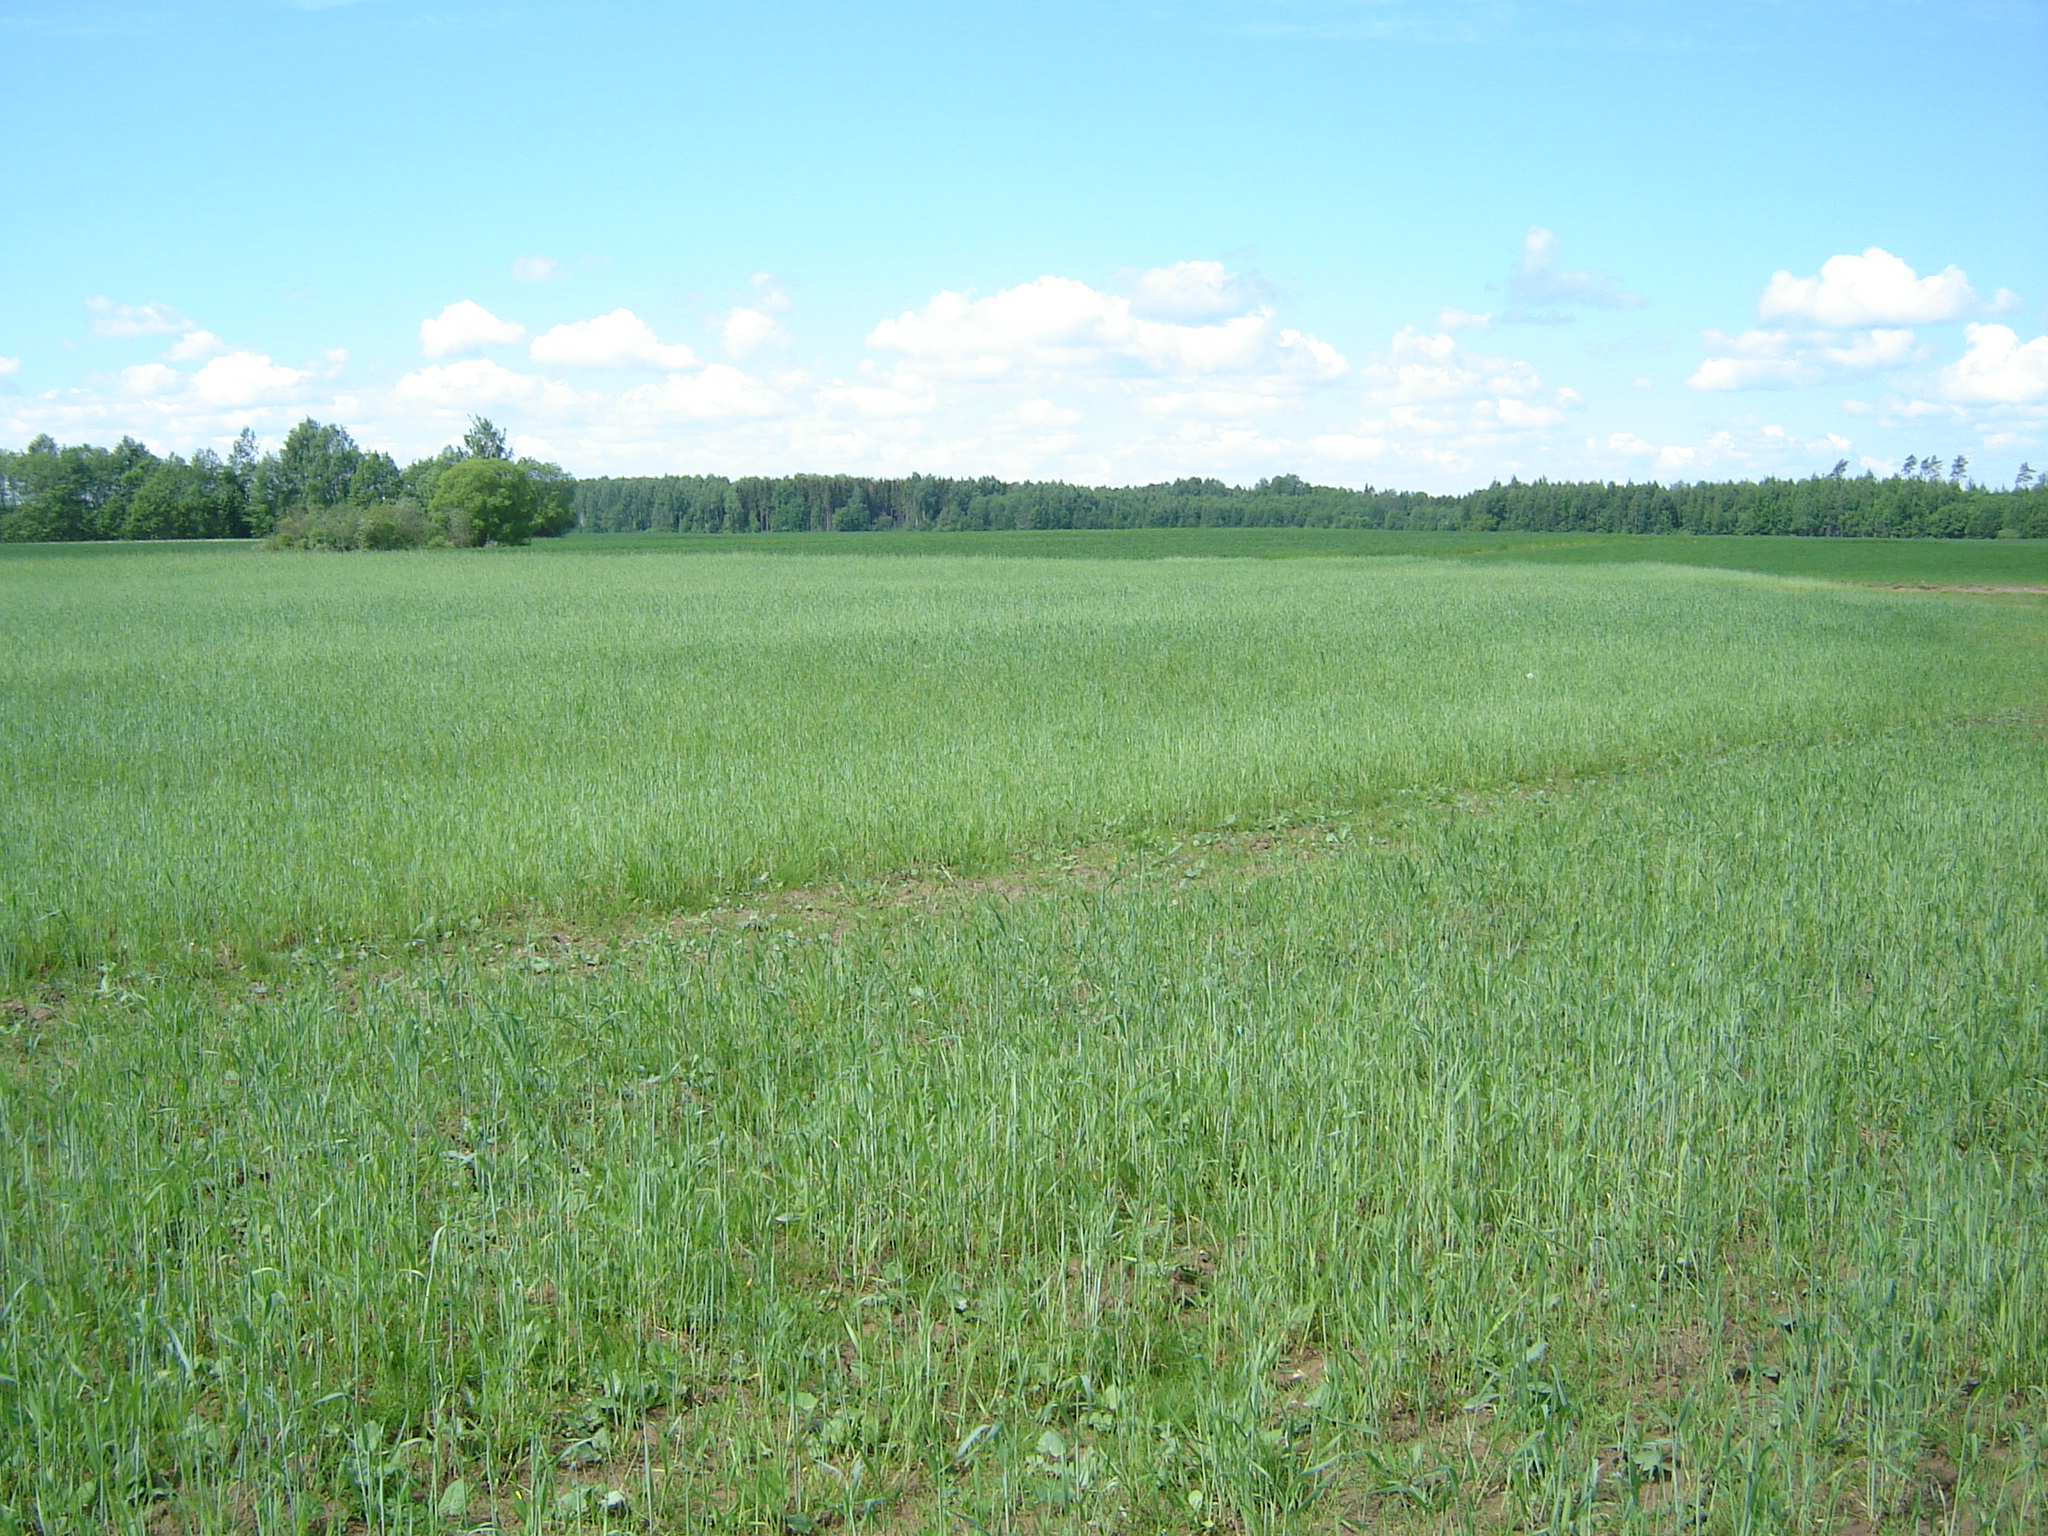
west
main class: Cropland
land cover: Rye
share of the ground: > 75 %
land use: Agriculture (excluding fallow land and kitchen gardens)
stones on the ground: < 10 %
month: May
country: LT
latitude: 55.7933
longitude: 25.1550
